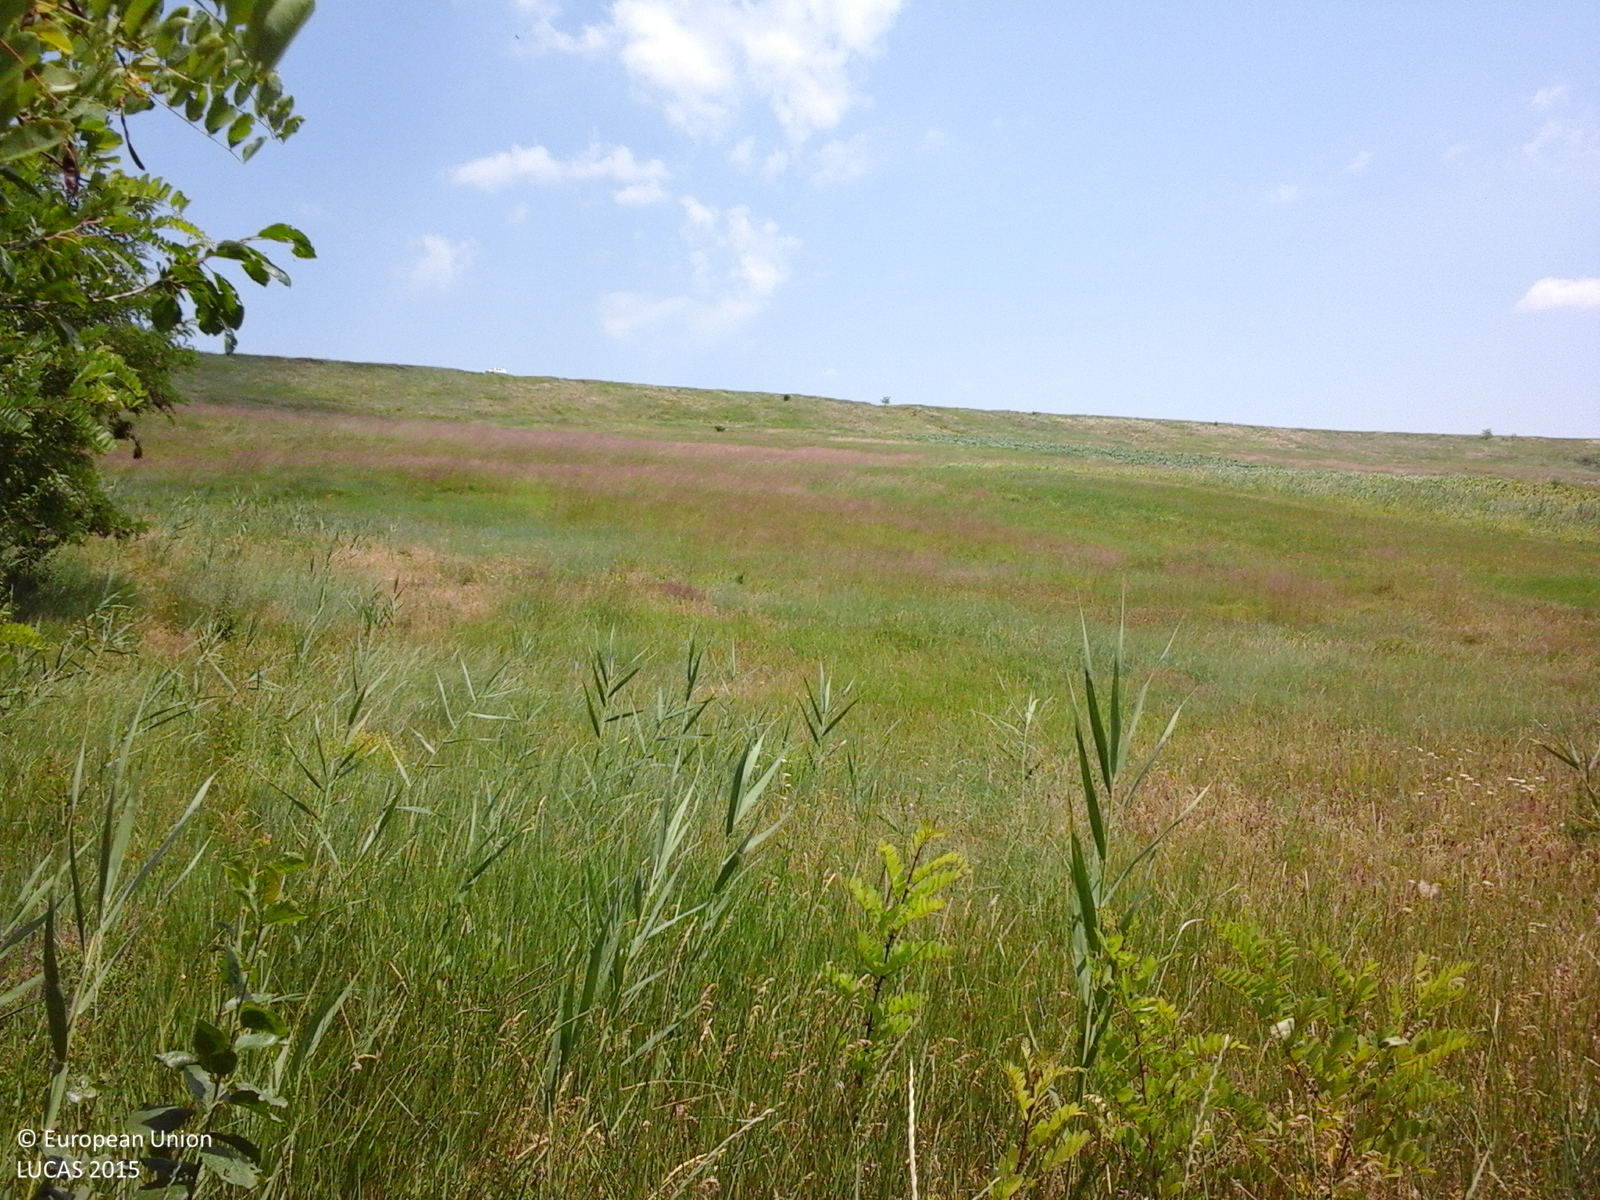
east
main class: Cropland
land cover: Vineyards
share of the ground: > 75 %
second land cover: Other bare soil
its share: > 75 %
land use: Agriculture (excluding fallow land and kitchen gardens)
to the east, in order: Vineyards; Other bare soil; Other fruit trees and berries; Fences; Grassland without tree/shrub cover
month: June
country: RO
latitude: 47.2050
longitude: 27.6663
